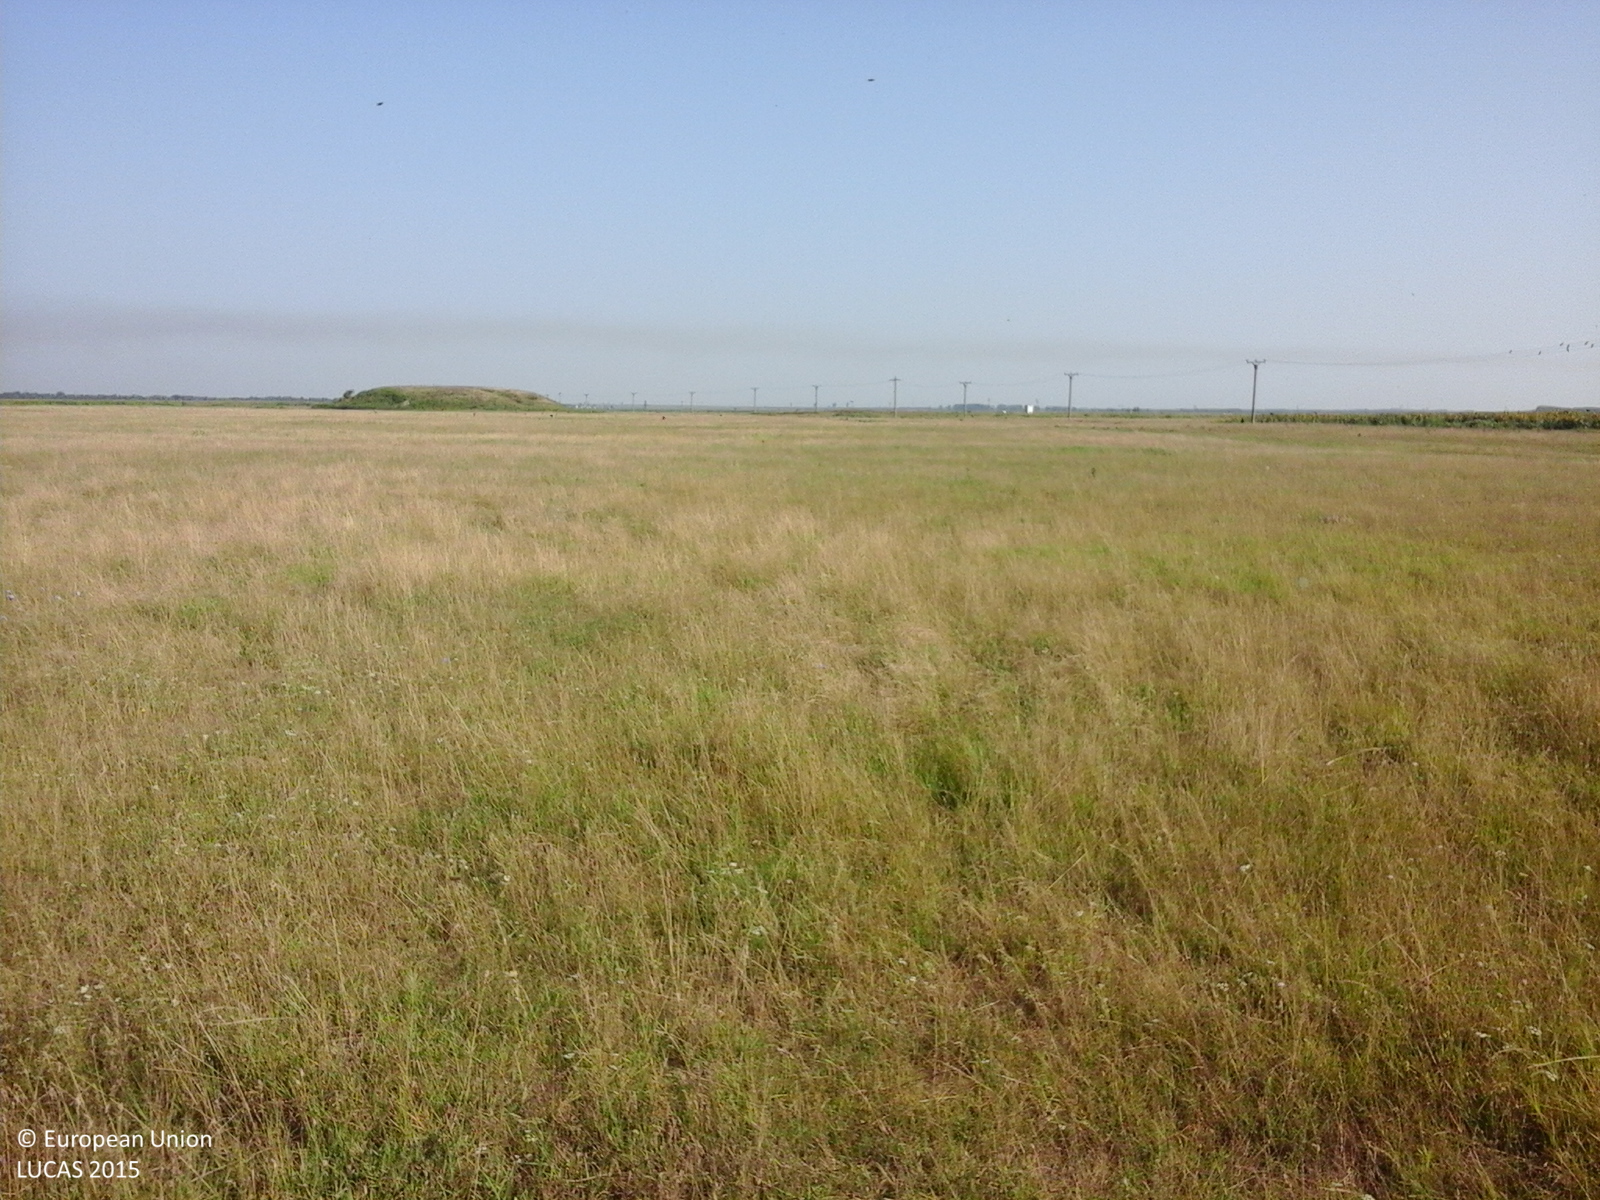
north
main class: Grassland
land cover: Grassland without tree/shrub cover
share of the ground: > 75 %
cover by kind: herbaceous plants 100 %
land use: Agriculture (excluding fallow land and kitchen gardens)
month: July
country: RO
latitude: 44.1499
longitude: 26.8877
